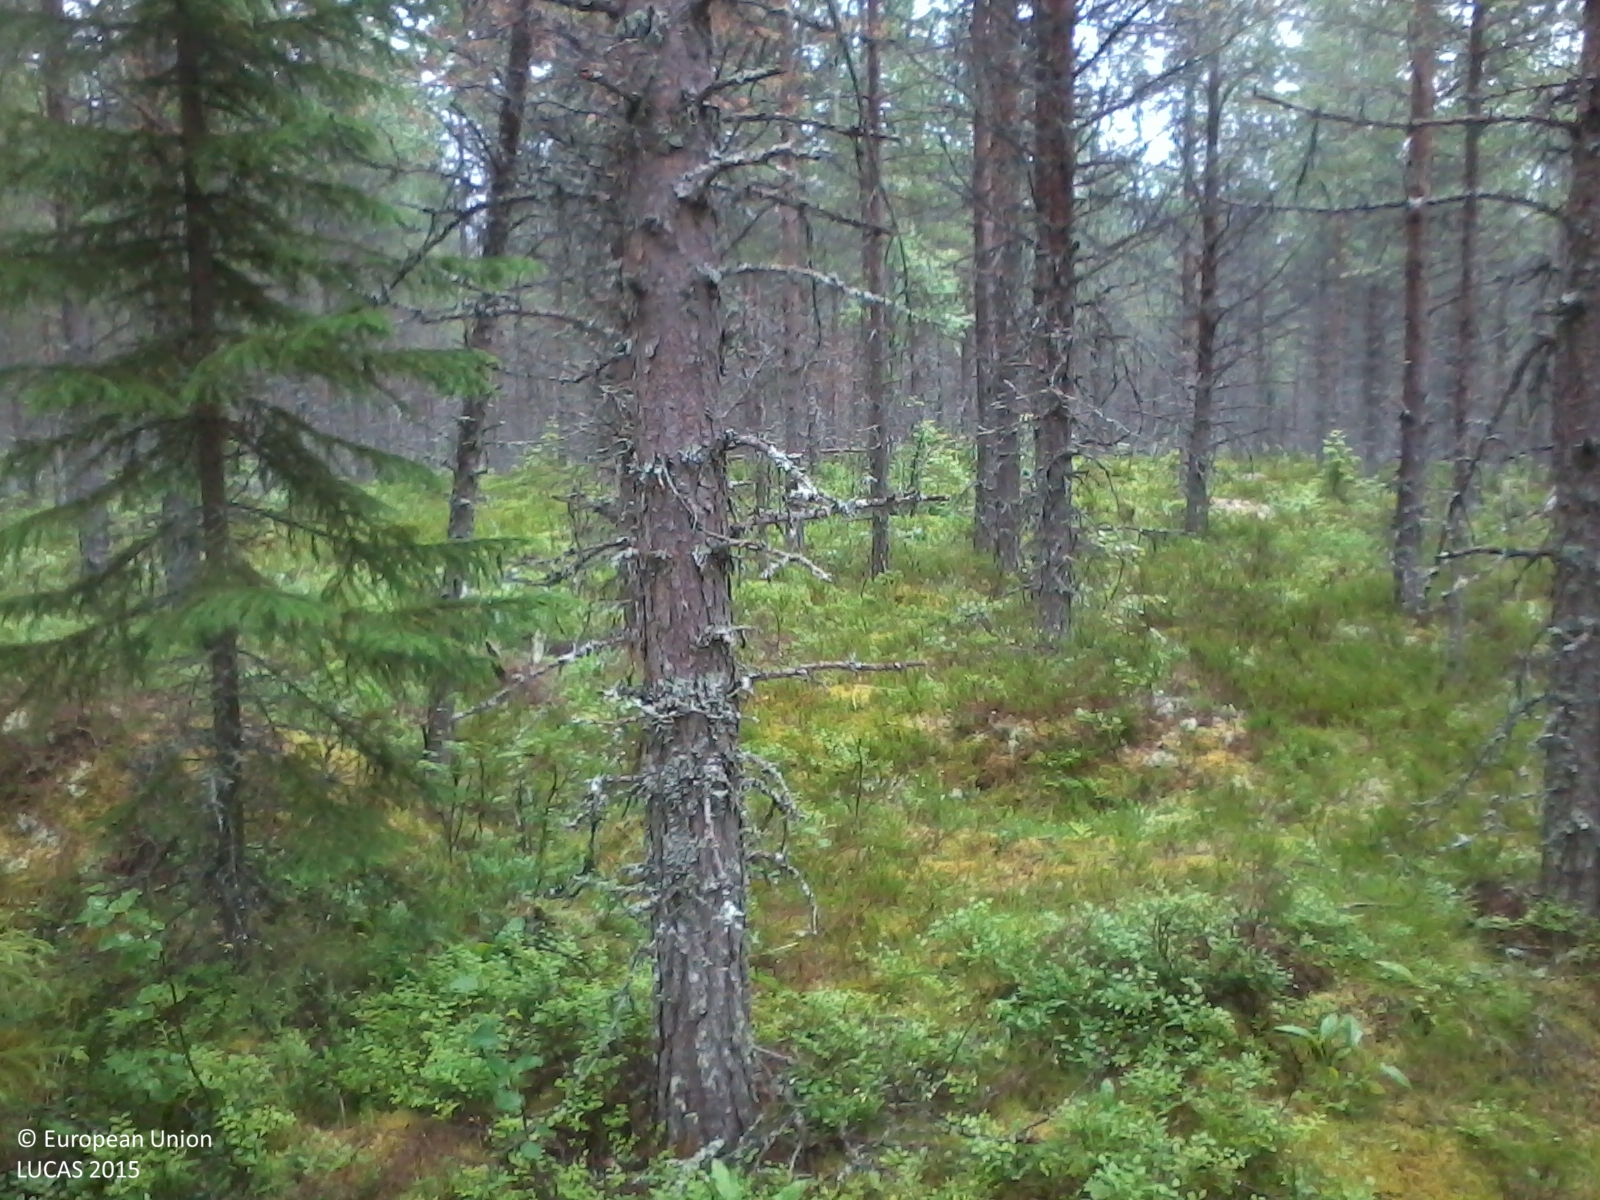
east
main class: Woodland
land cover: Pine dominated coniferous woodland
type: boreal forest
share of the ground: > 75 %
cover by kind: coniferous forest trees 75 %, lichens and mosses 15 %, shrubs 10 %
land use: Forestry
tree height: > 5 m
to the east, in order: Pine dominated coniferous woodland
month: August
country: SE
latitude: 62.8879
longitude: 16.9201
